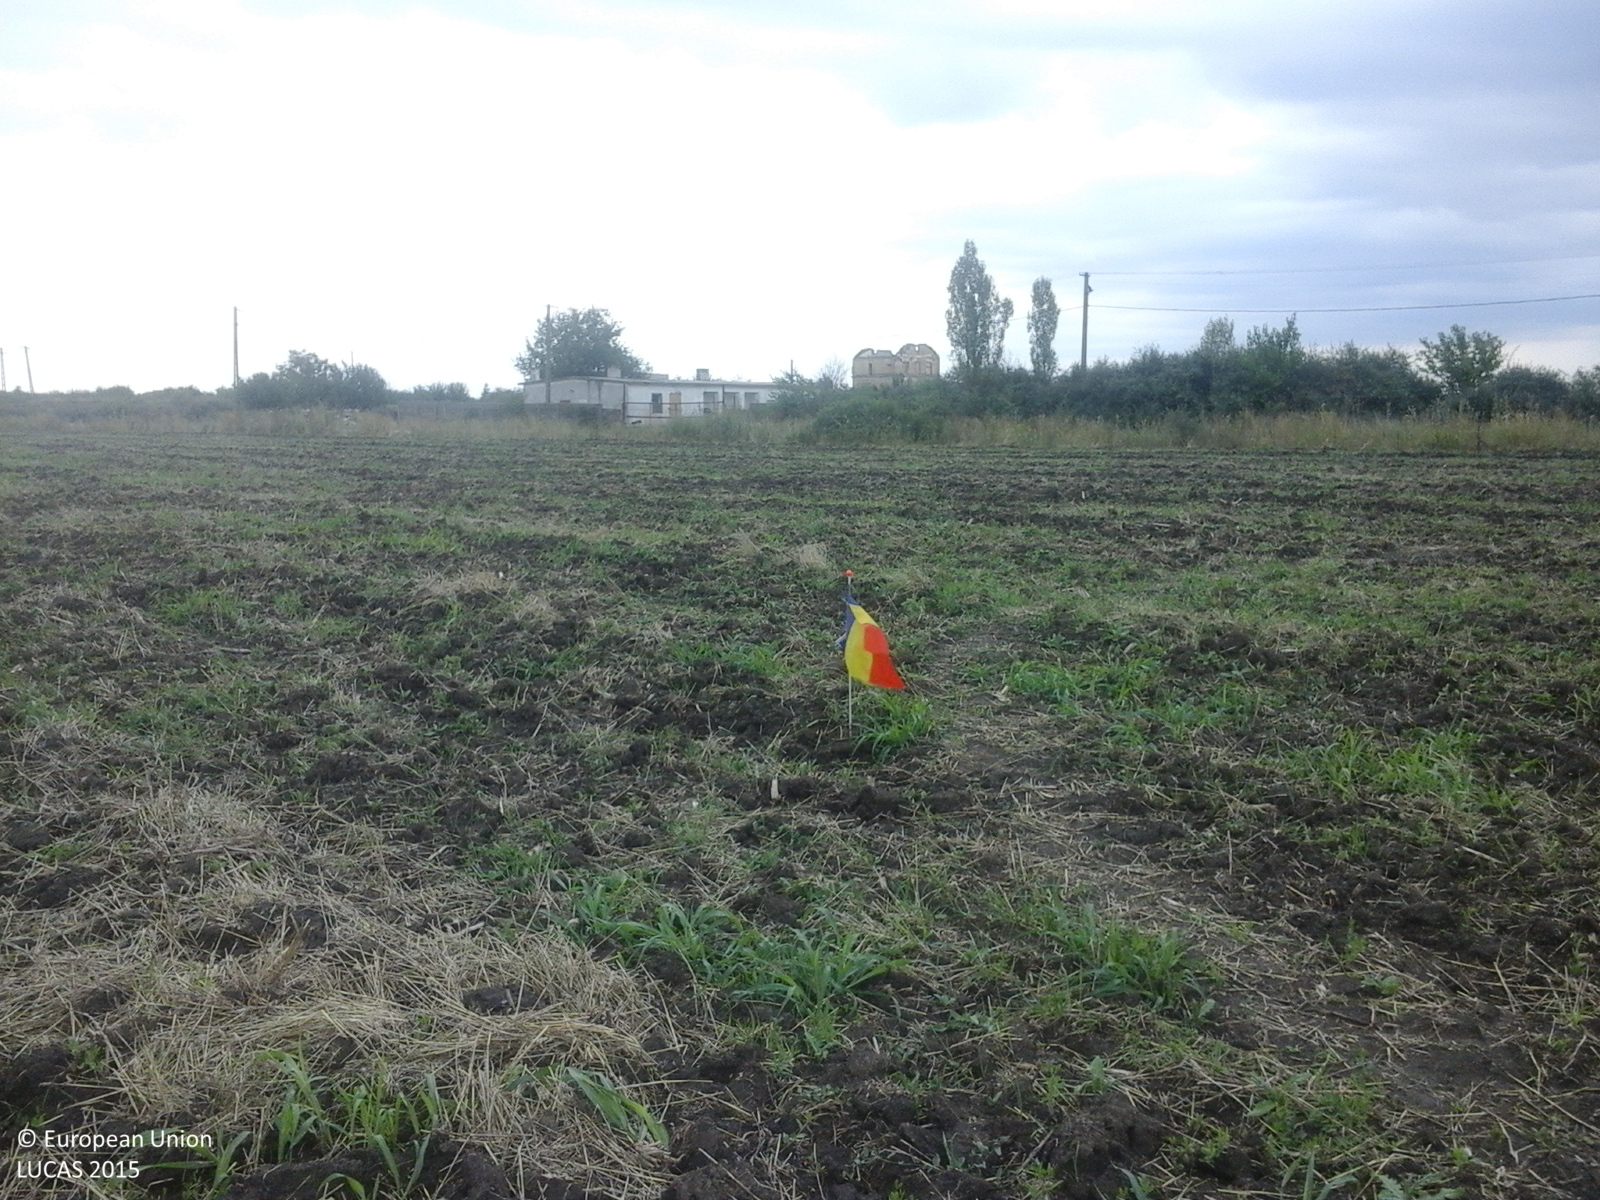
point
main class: Cropland
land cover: Common wheat
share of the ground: < 10 %
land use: Agriculture (excluding fallow land and kitchen gardens)
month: August
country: RO
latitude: 45.4609
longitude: 21.1155
